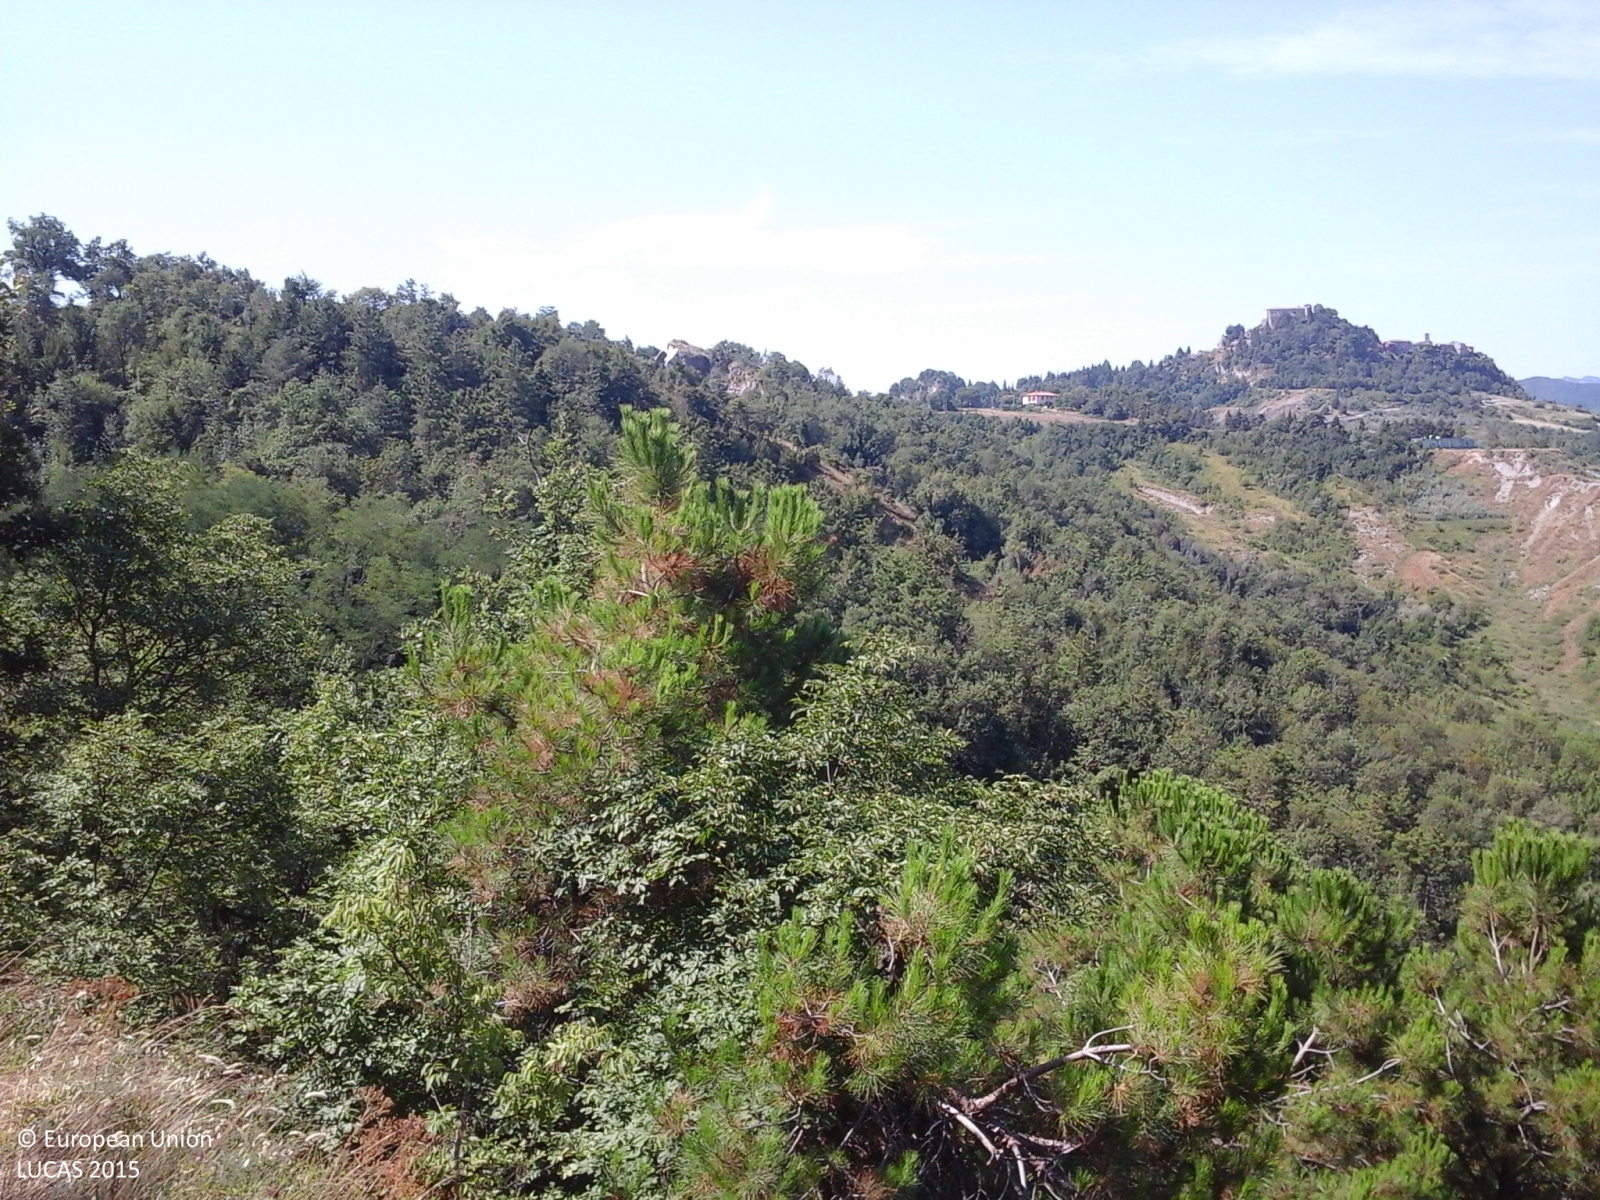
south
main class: Woodland
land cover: Broadleaved woodland
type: mesophytic deciduous forest
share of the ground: > 75 %
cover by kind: broadleaved forest trees 100 %
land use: Semi-natural and natural areas not in use
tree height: > 5 m
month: July
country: IT
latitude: 43.9805
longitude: 12.3756
